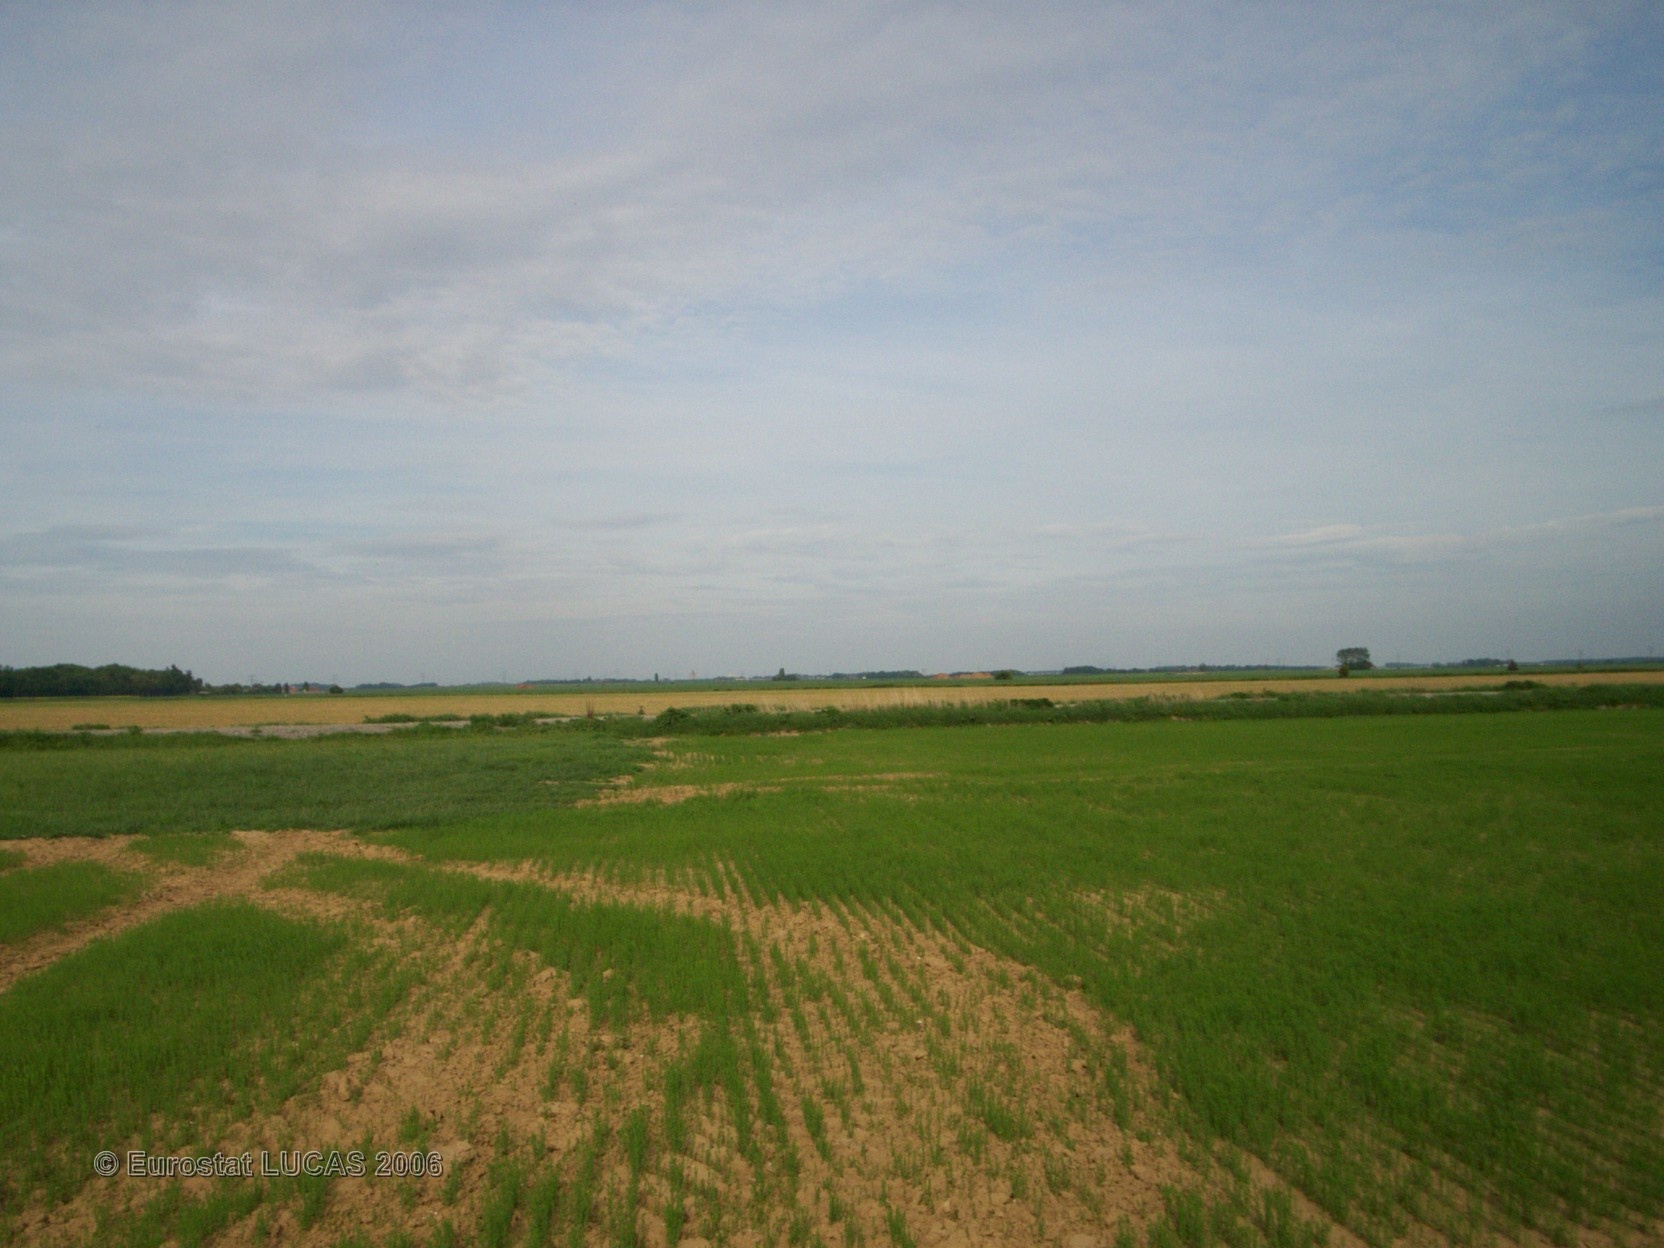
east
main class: Cropland
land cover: Other fibre and oleaginous crops
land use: Agriculture (excluding fallow land and kitchen gardens)
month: May
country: FR
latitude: 48.6015
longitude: 2.7899
